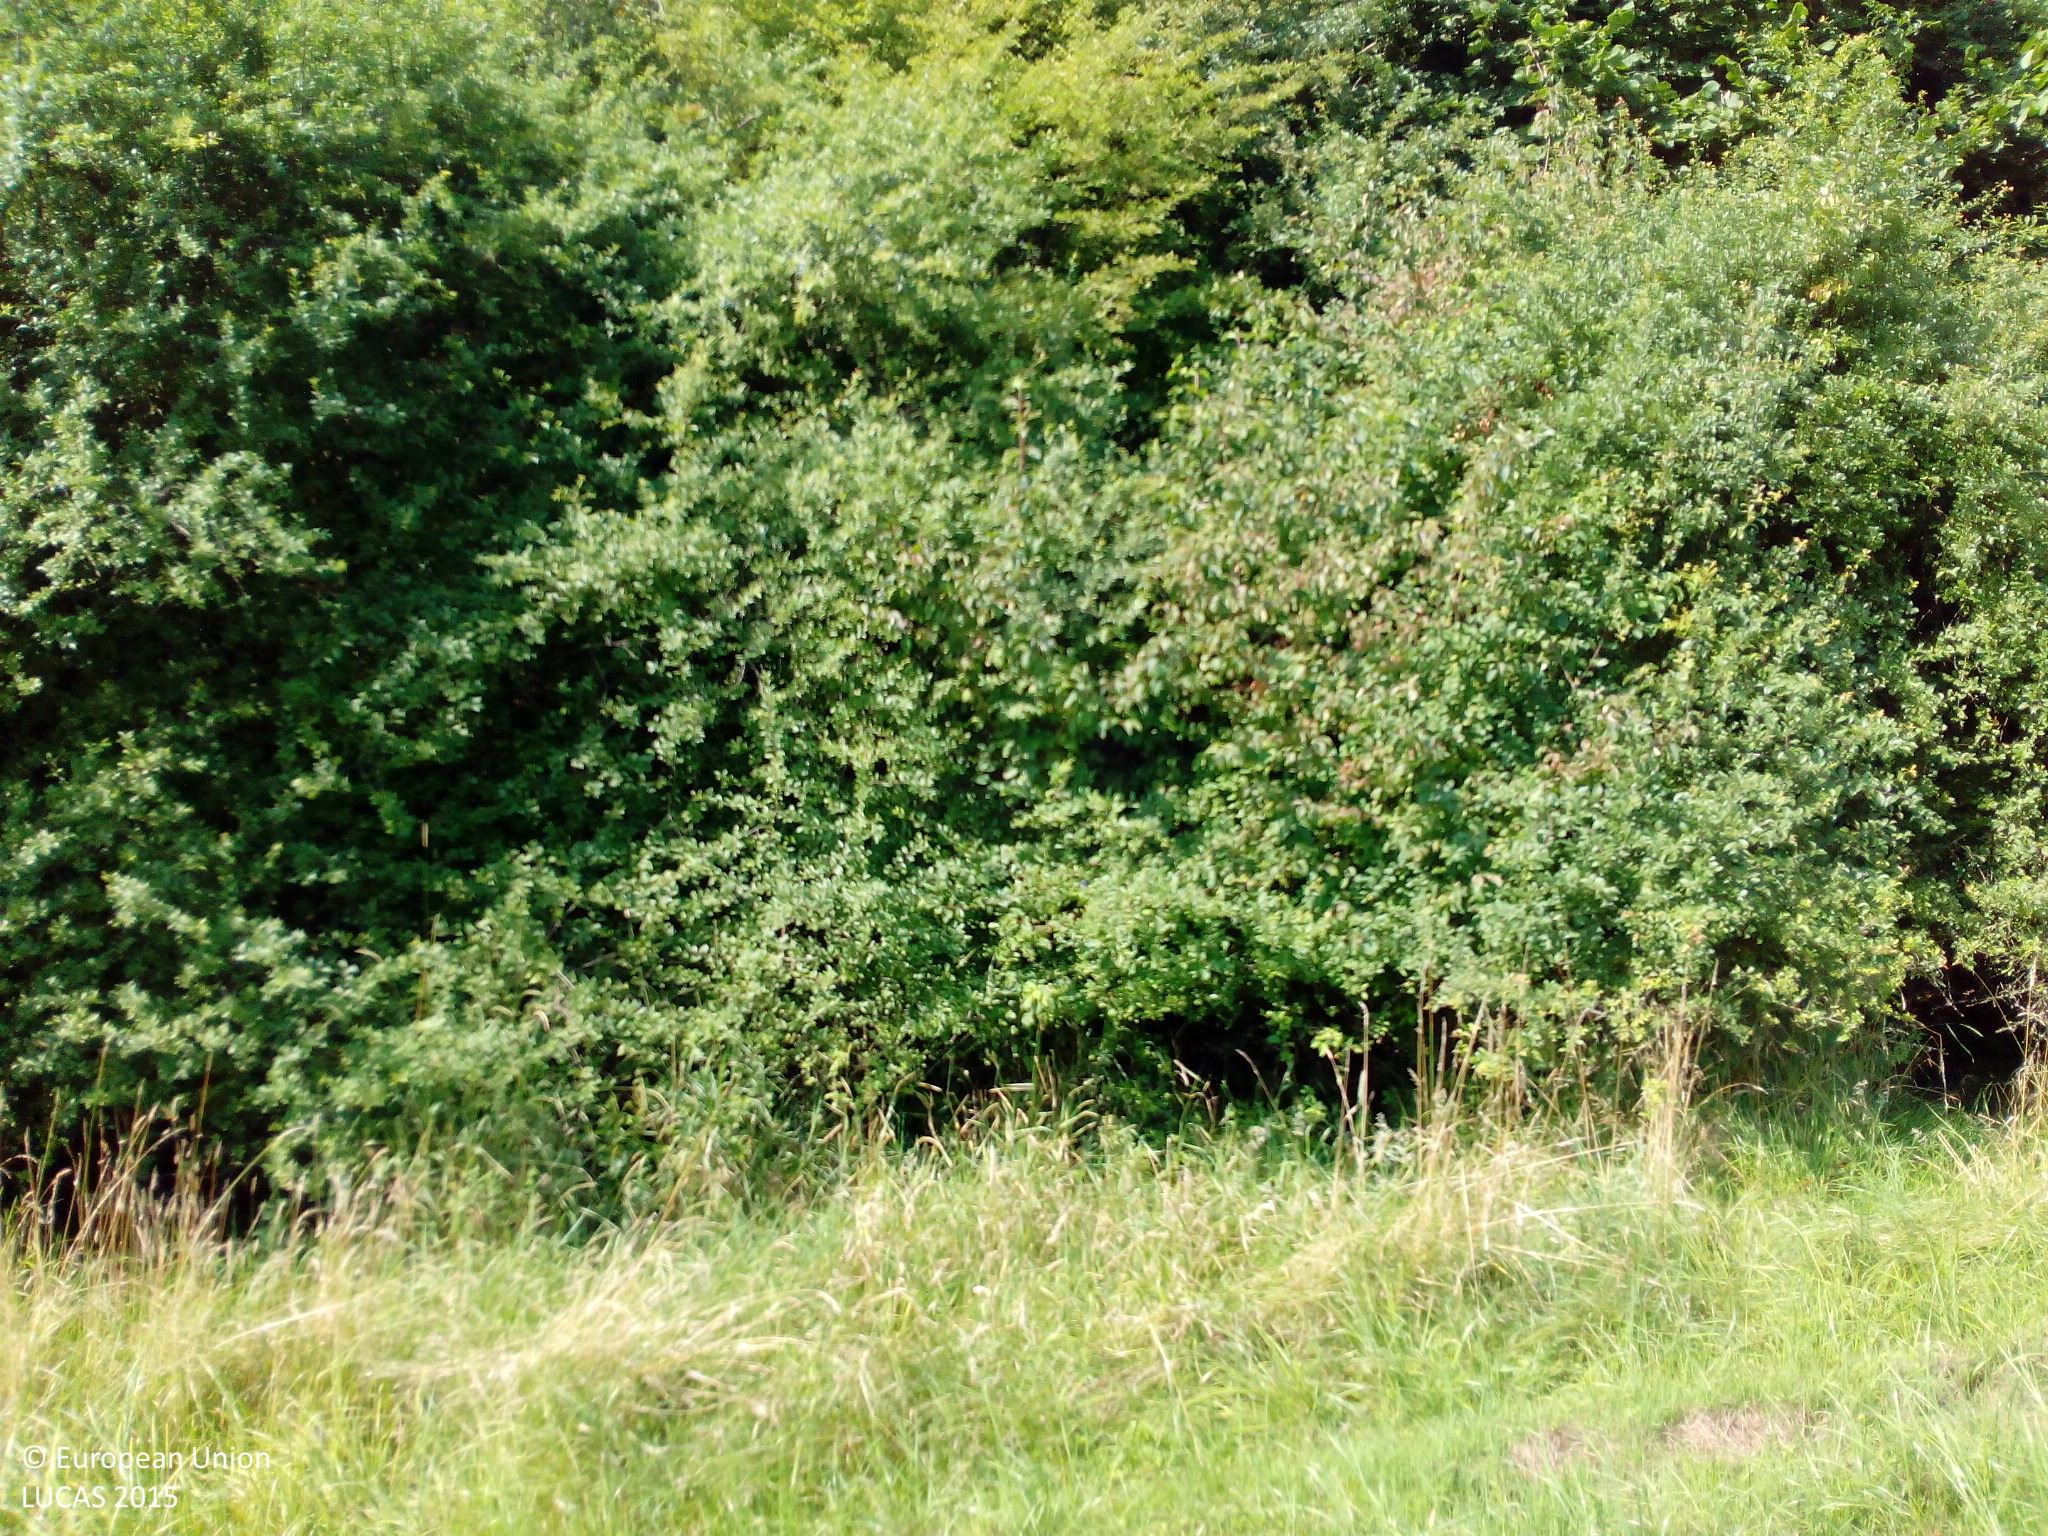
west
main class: Grassland
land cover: Grassland without tree/shrub cover
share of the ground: > 75 %
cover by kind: herbaceous plants 100 %
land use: Agriculture (excluding fallow land and kitchen gardens)
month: July
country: DE
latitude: 48.2756
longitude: 12.8960
